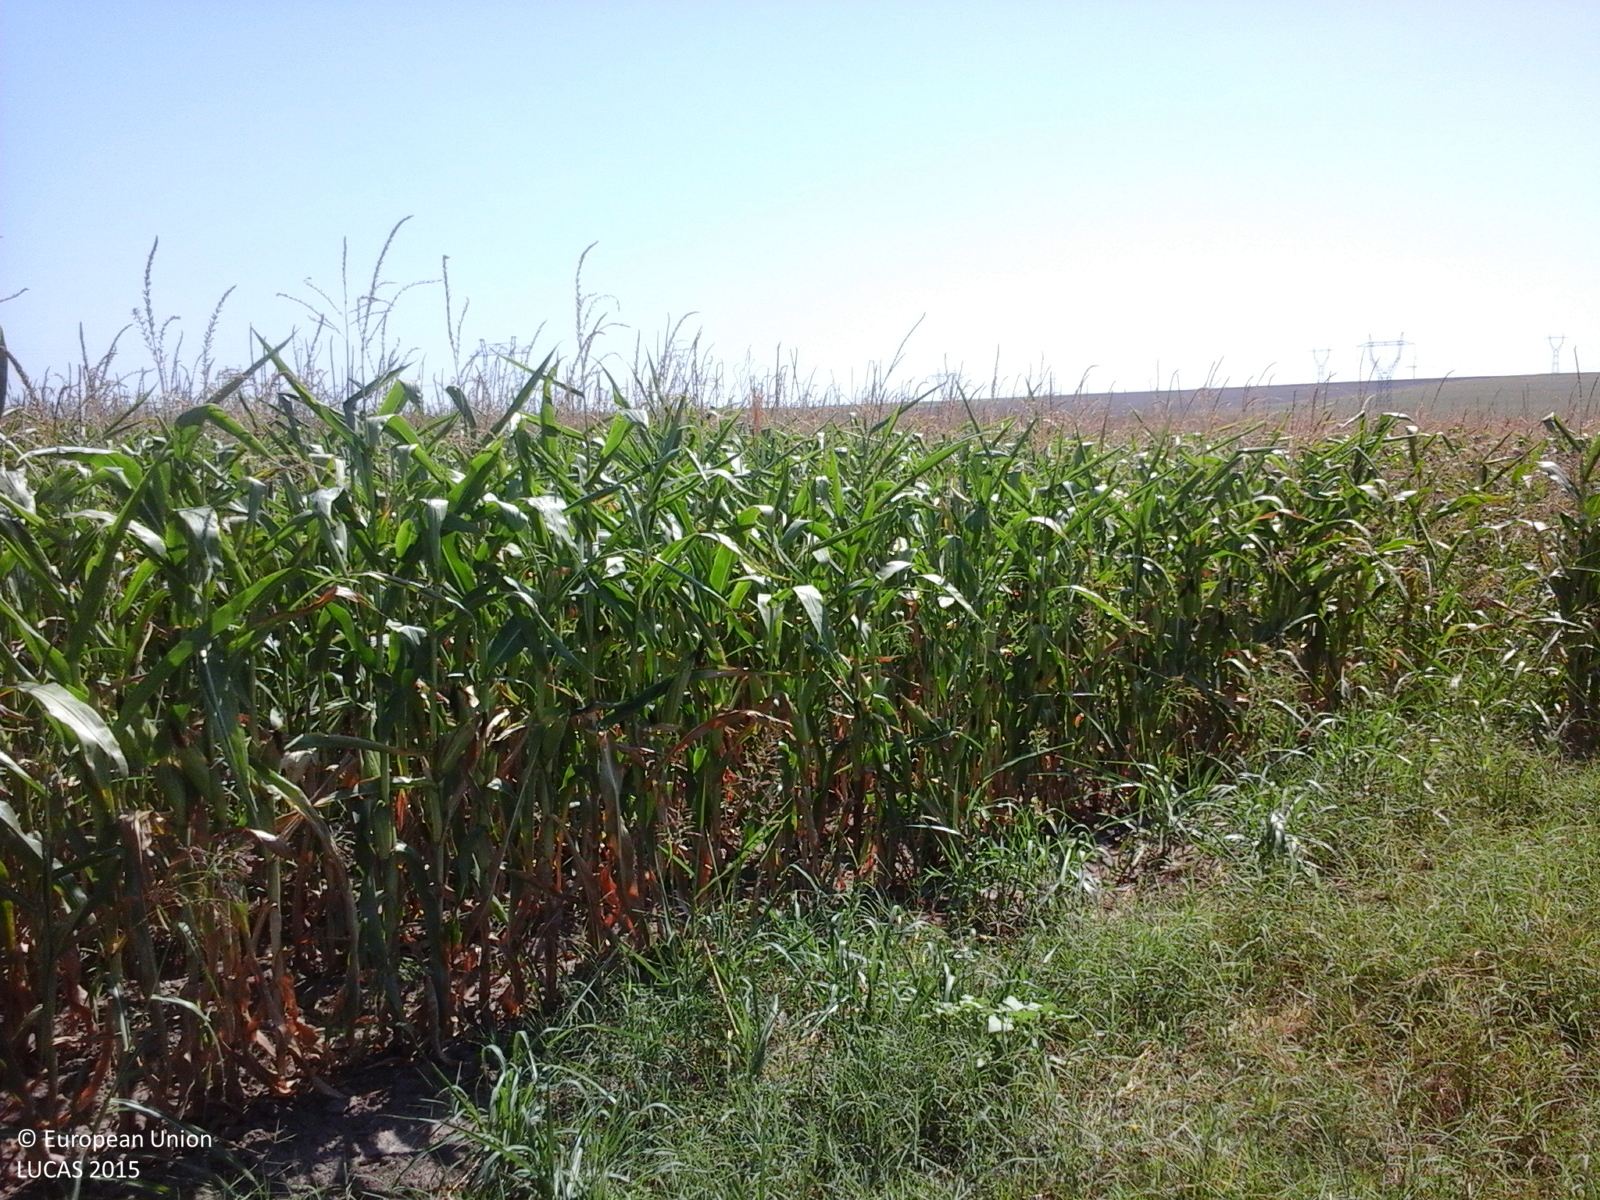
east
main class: Cropland
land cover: Maize
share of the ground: > 75 %
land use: Agriculture (excluding fallow land and kitchen gardens)
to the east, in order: Maize; Electric lines; Maize; Lucerne; Maize
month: August
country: RO
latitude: 44.4373
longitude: 28.2177
